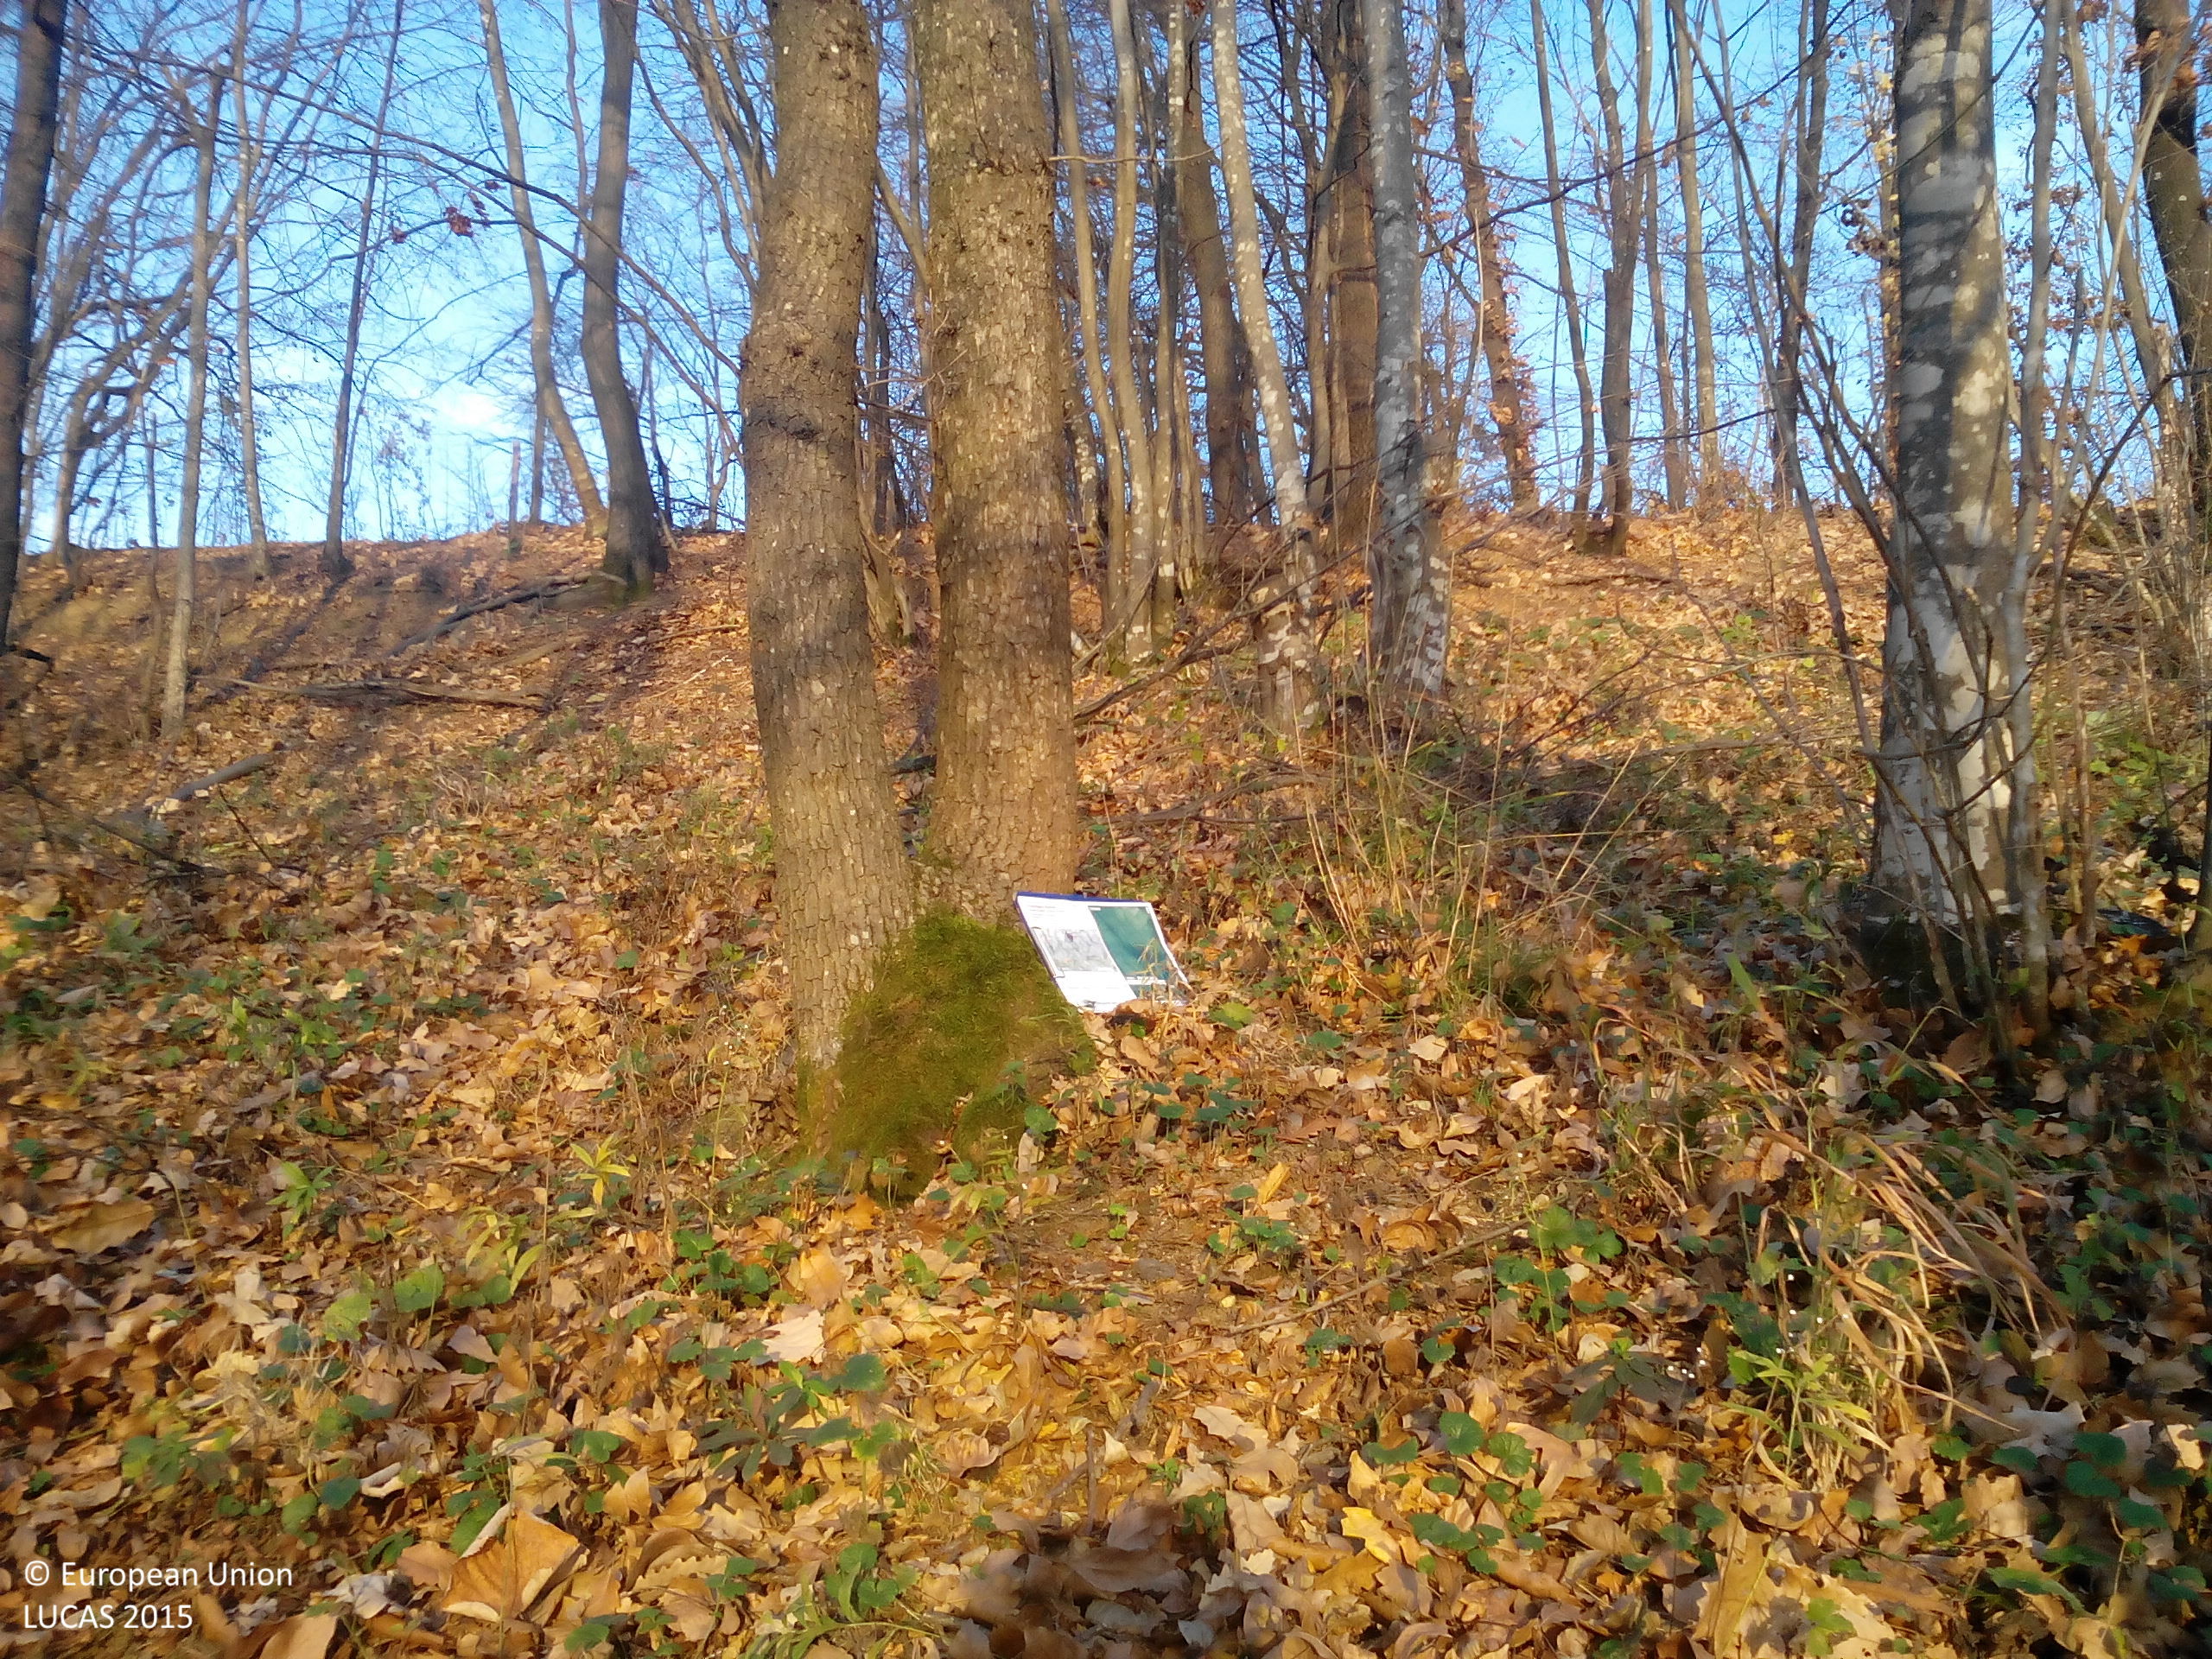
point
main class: Woodland
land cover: Broadleaved woodland
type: beech forest
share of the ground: > 75 %
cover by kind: broadleaved forest trees 80 %, shrubs 15 %, herbaceous plants 5 %
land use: Forestry
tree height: > 5 m
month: November
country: BG
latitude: 43.2469
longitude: 23.7541
